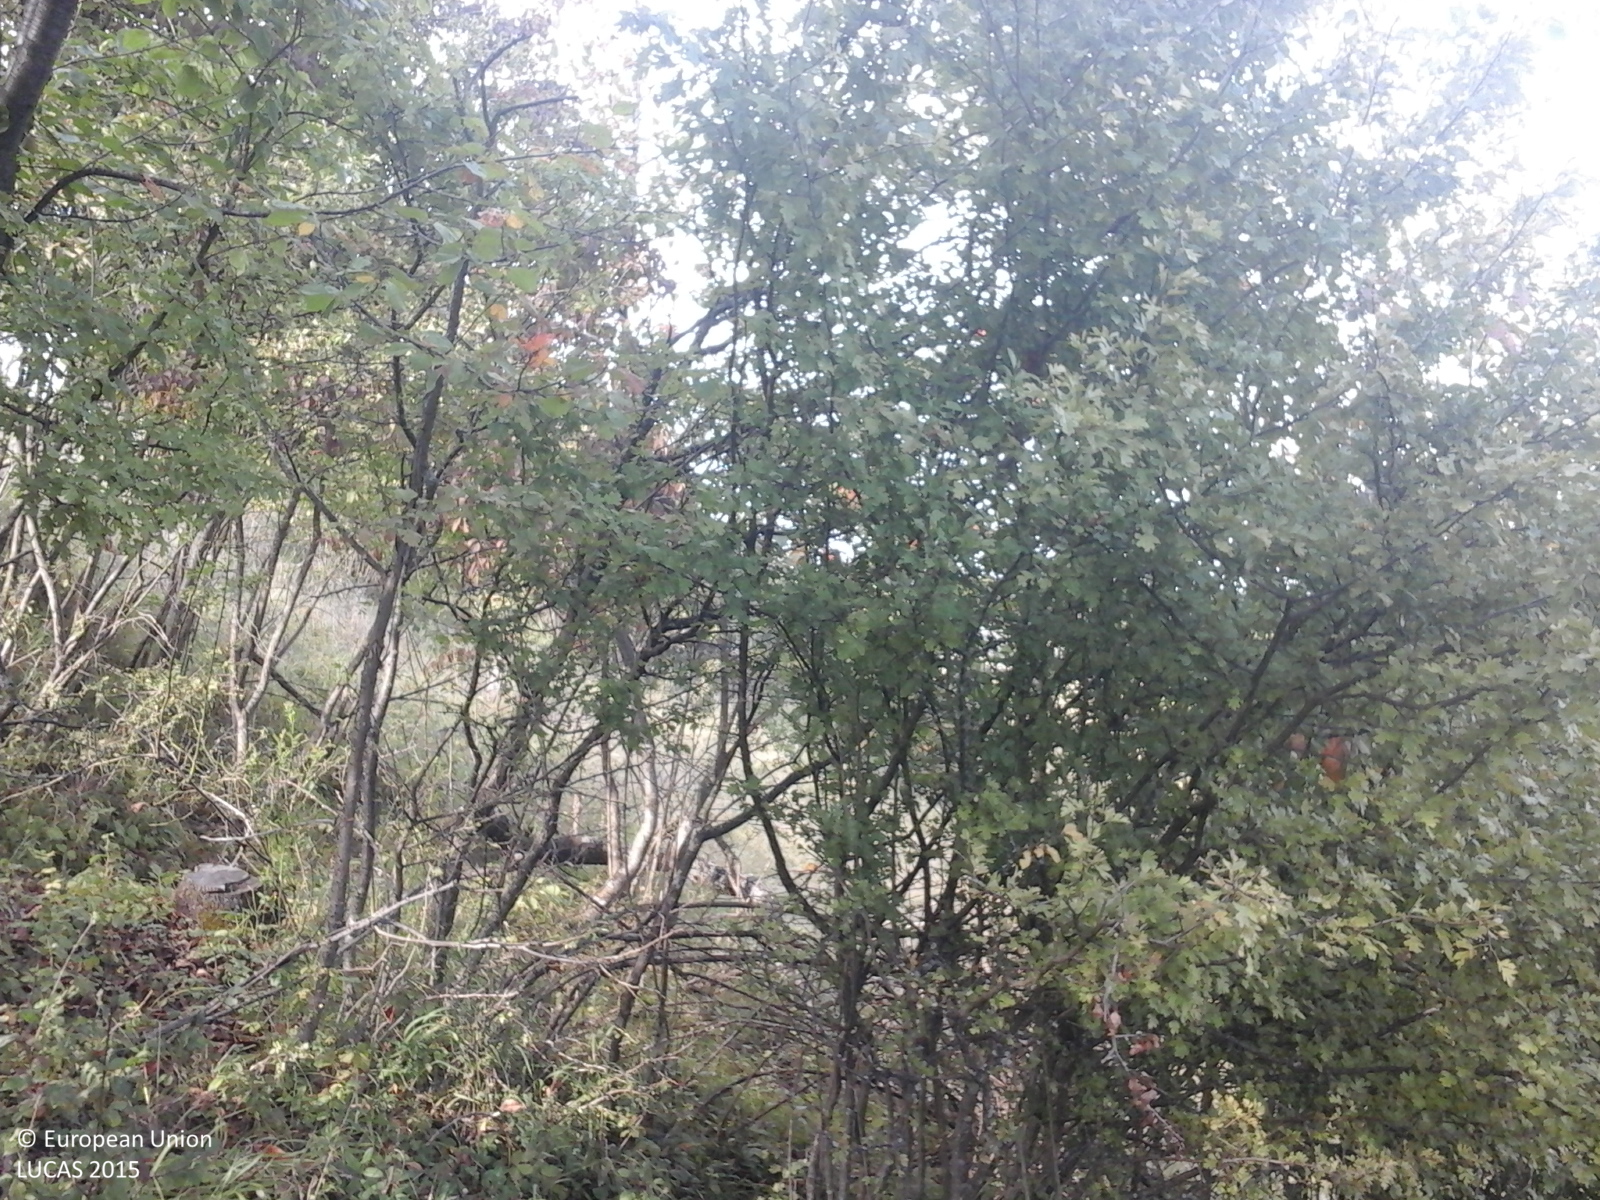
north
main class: Grassland
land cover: Grassland with sparse tree/shrub cover
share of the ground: > 75 %
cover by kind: herbaceous plants 85 %, shrubs 10 %, broadleaved forest trees 5 %
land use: Agriculture (excluding fallow land and kitchen gardens)
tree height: < 5 m
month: September
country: RO
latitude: 46.7416
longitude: 22.9785
